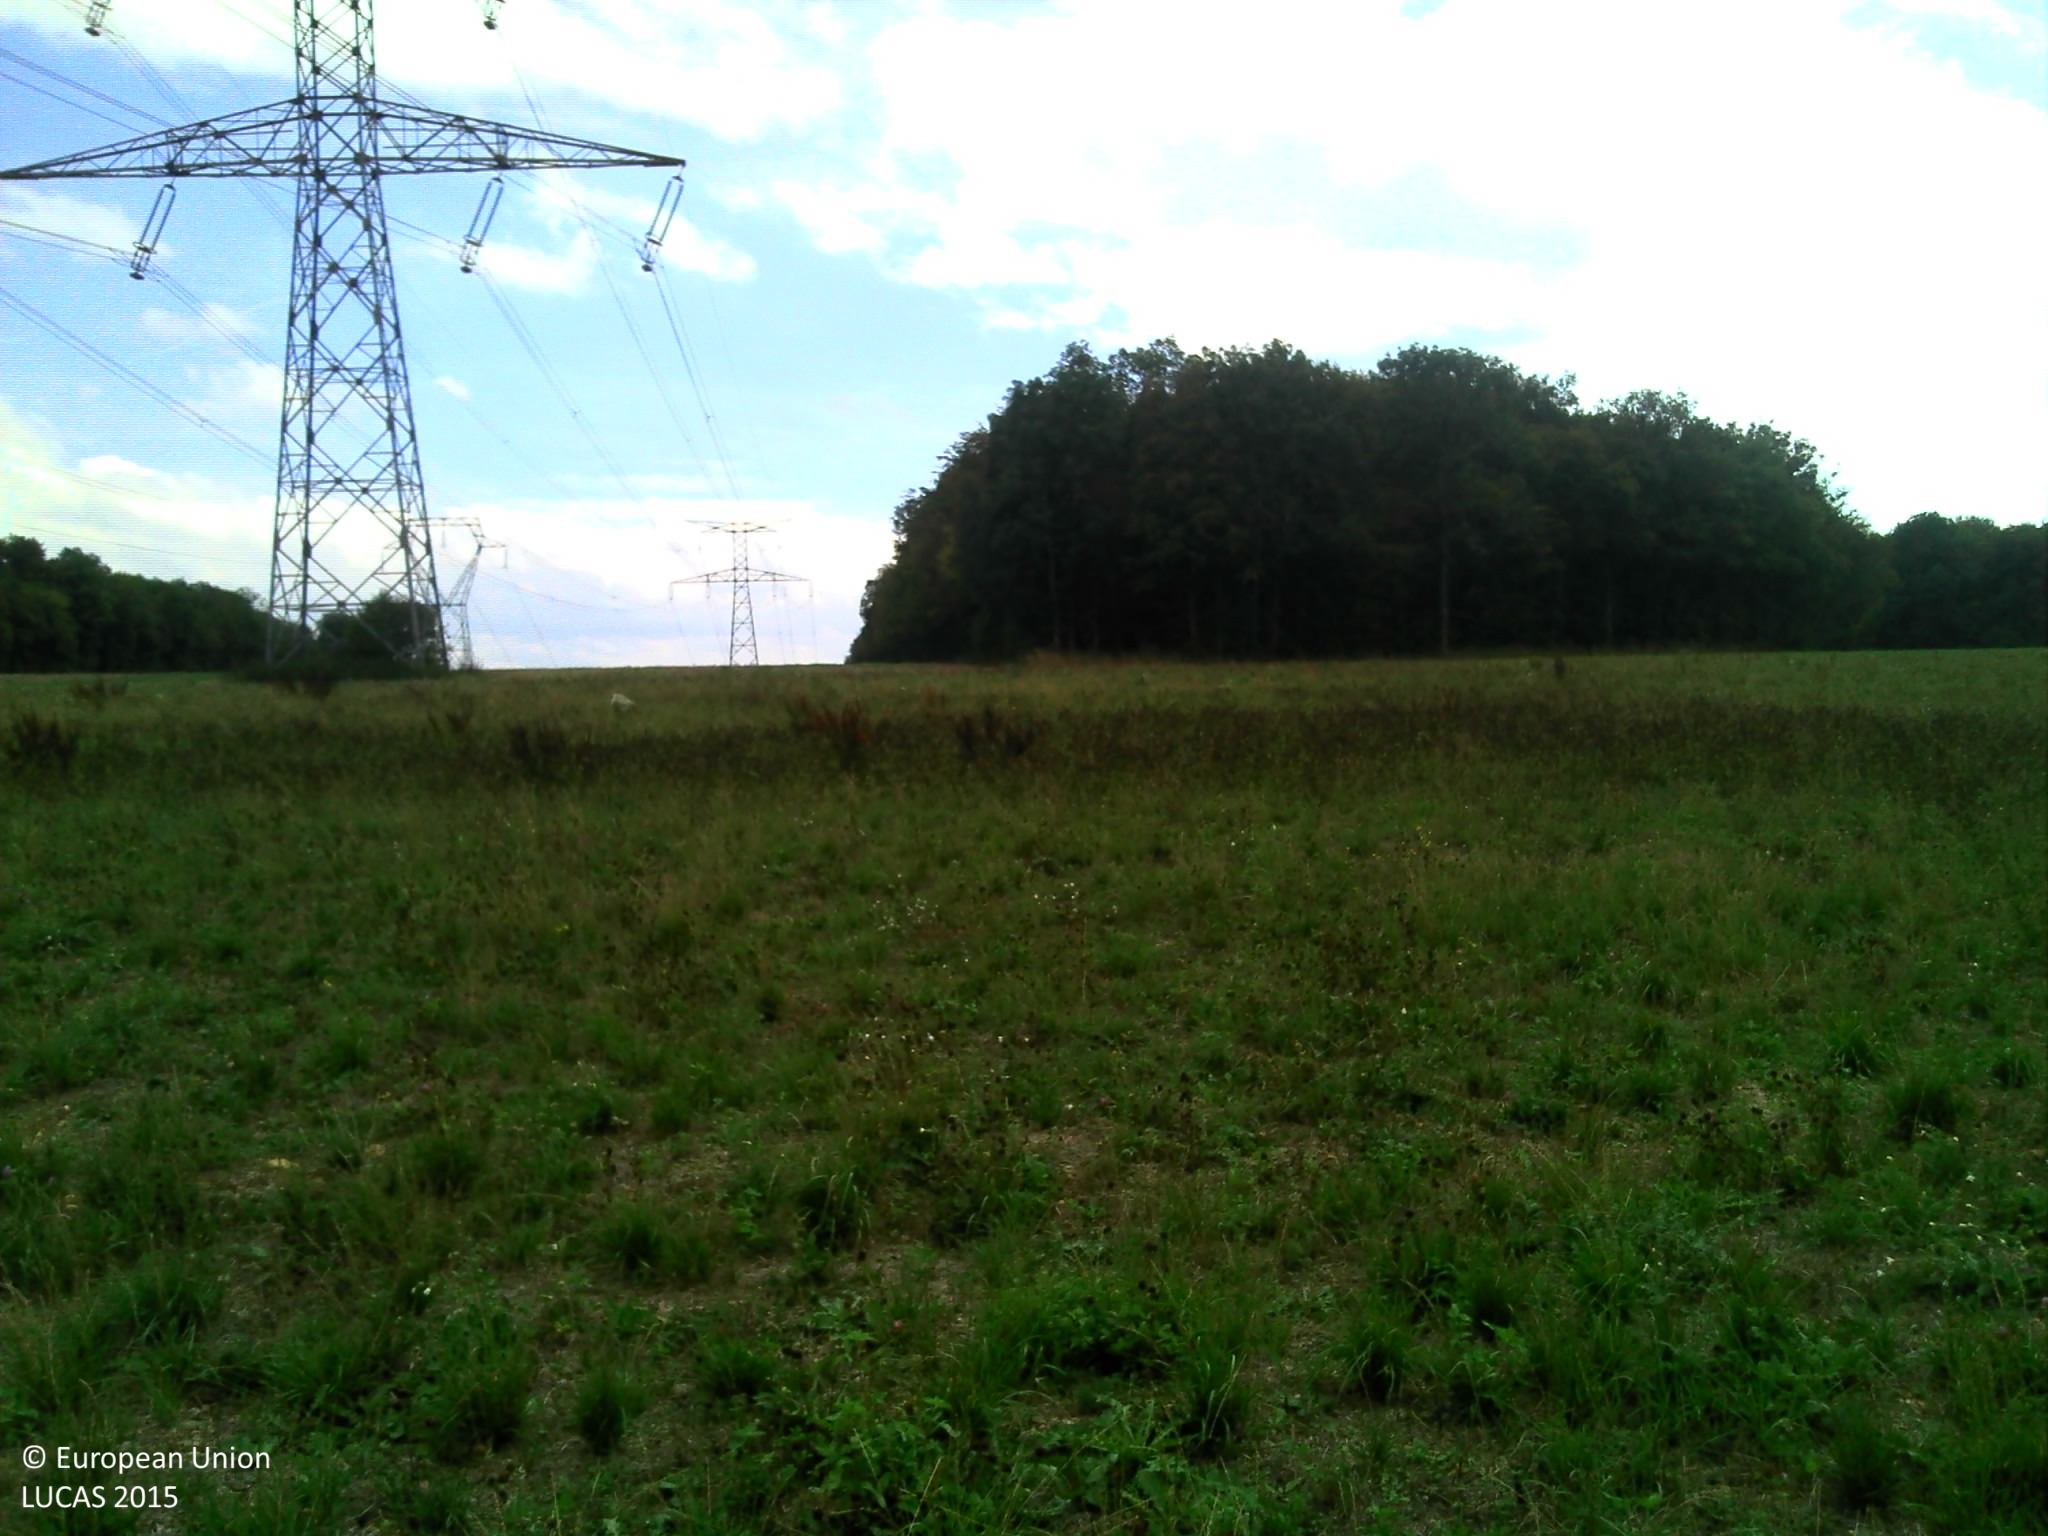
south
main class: Cropland
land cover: Temporary grasslands
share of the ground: > 75 %
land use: Agriculture (excluding fallow land and kitchen gardens)
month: August
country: FR
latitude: 47.3023
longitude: 4.6964
